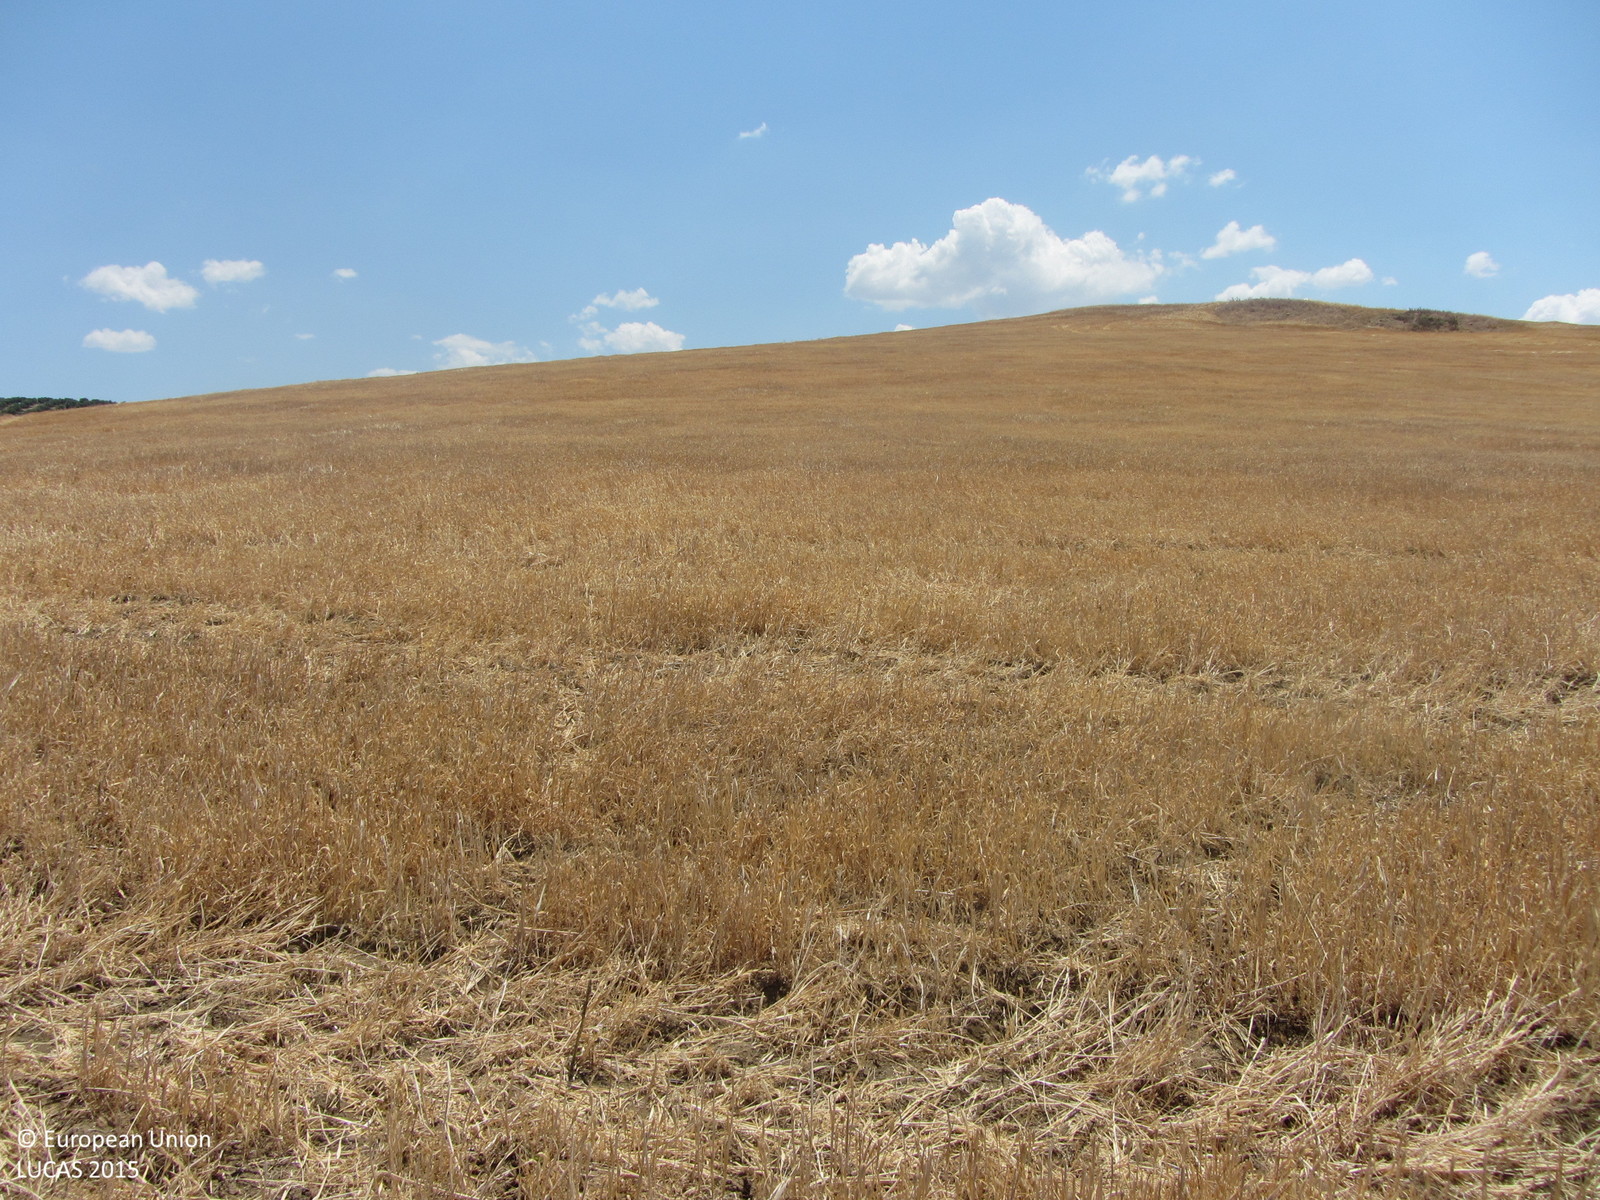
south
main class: Cropland
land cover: Barley
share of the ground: < 10 %
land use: Agriculture (excluding fallow land and kitchen gardens)
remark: Harvested field
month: June
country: ES
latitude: 37.8903
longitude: -3.8186
